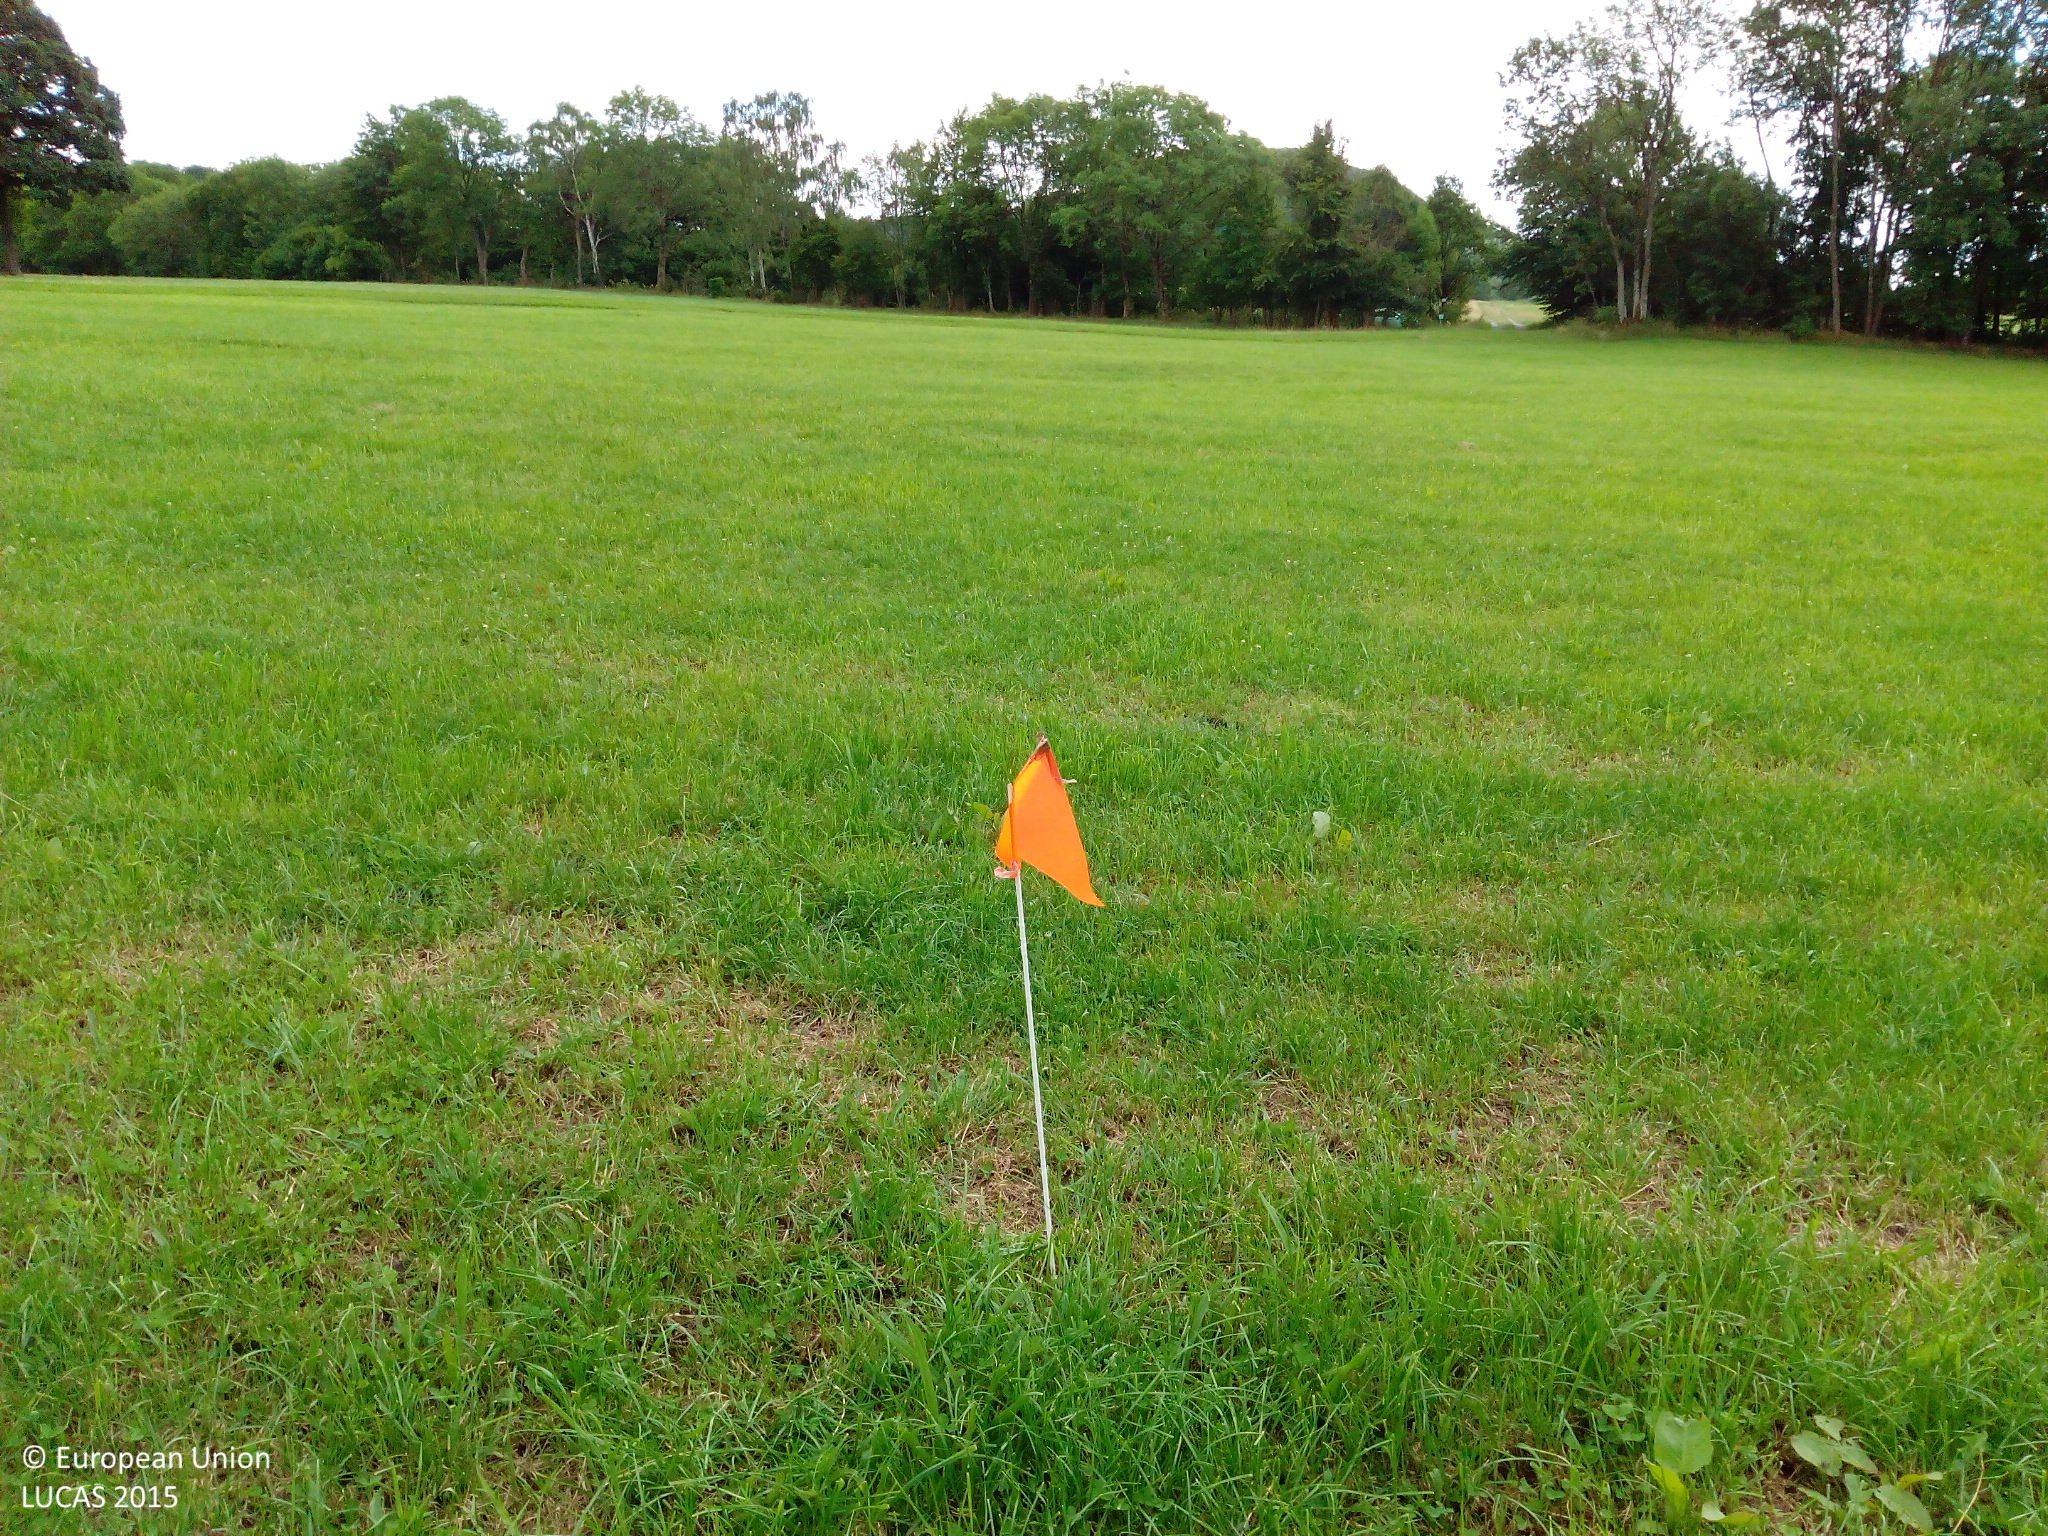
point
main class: Grassland
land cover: Grassland without tree/shrub cover
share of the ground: > 75 %
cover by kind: herbaceous plants 100 %
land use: Agriculture (excluding fallow land and kitchen gardens)
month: July
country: DE
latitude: 50.4899
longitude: 9.9014
